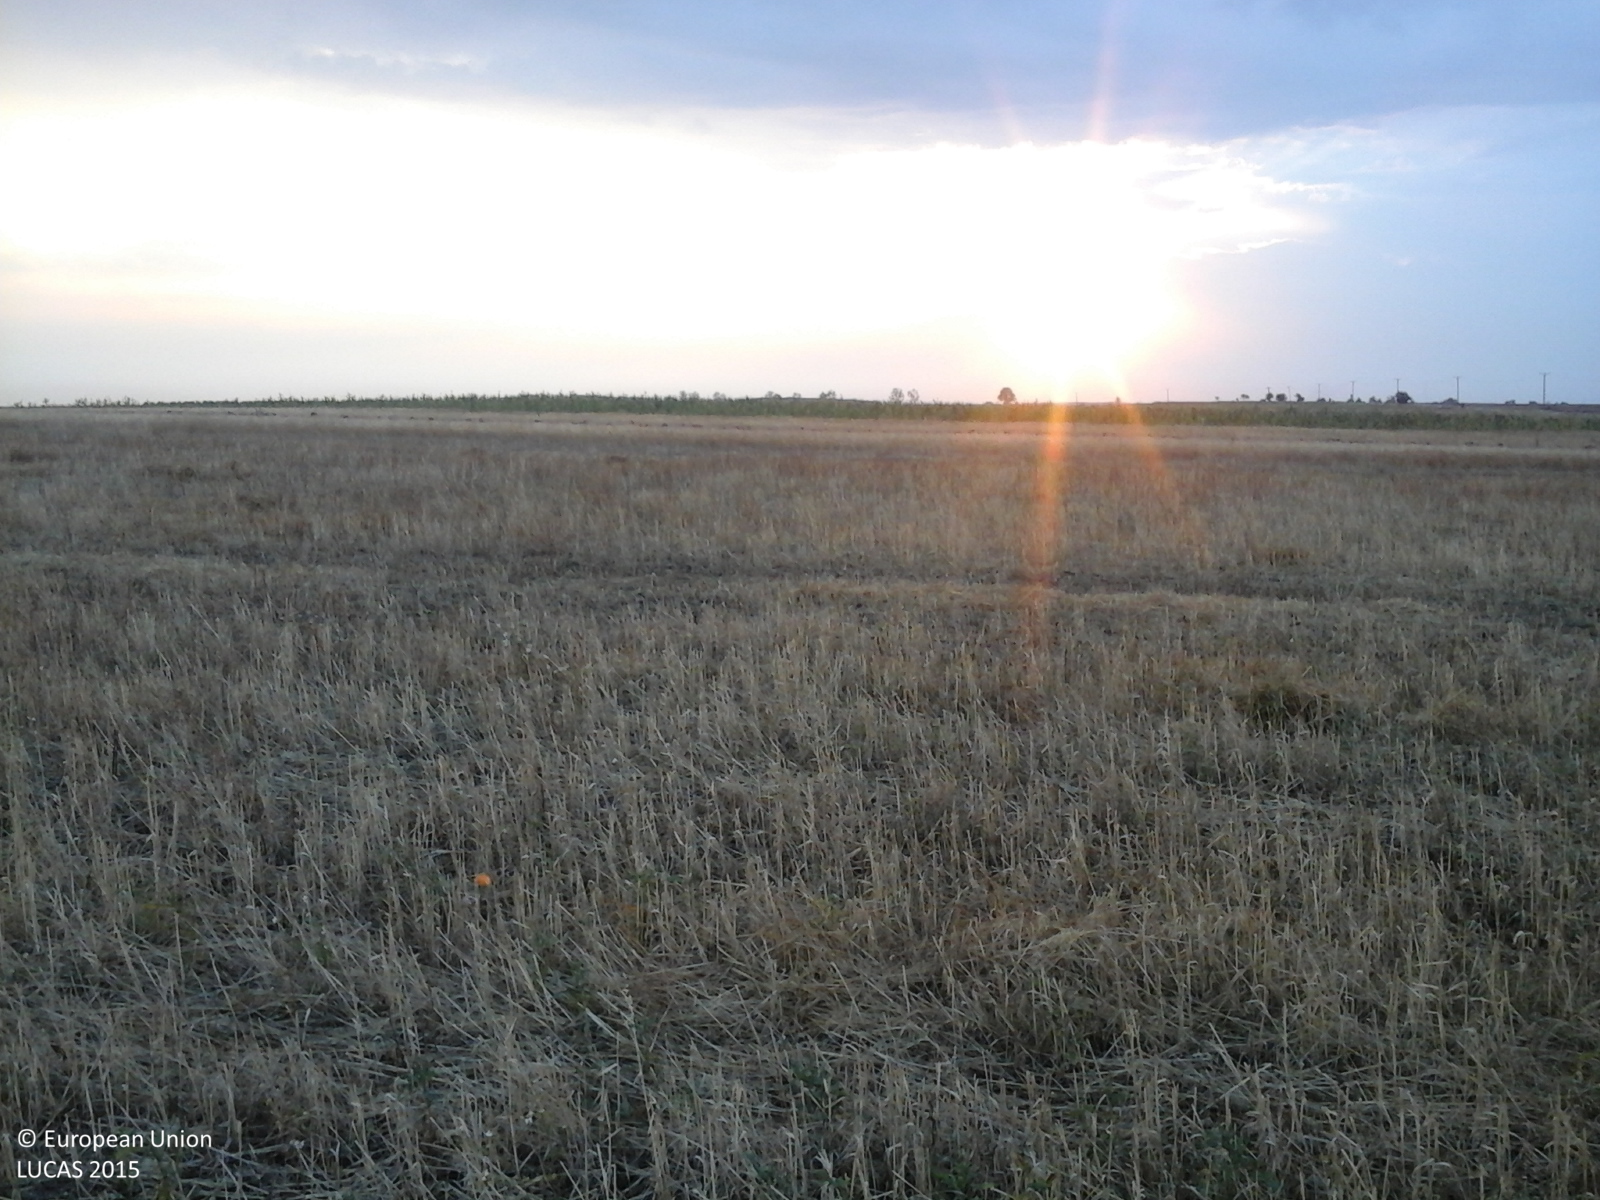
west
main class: Cropland
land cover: Mixed cereals for fodder
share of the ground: > 75 %
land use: Agriculture (excluding fallow land and kitchen gardens)
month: August
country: RO
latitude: 44.5332
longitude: 22.9947
